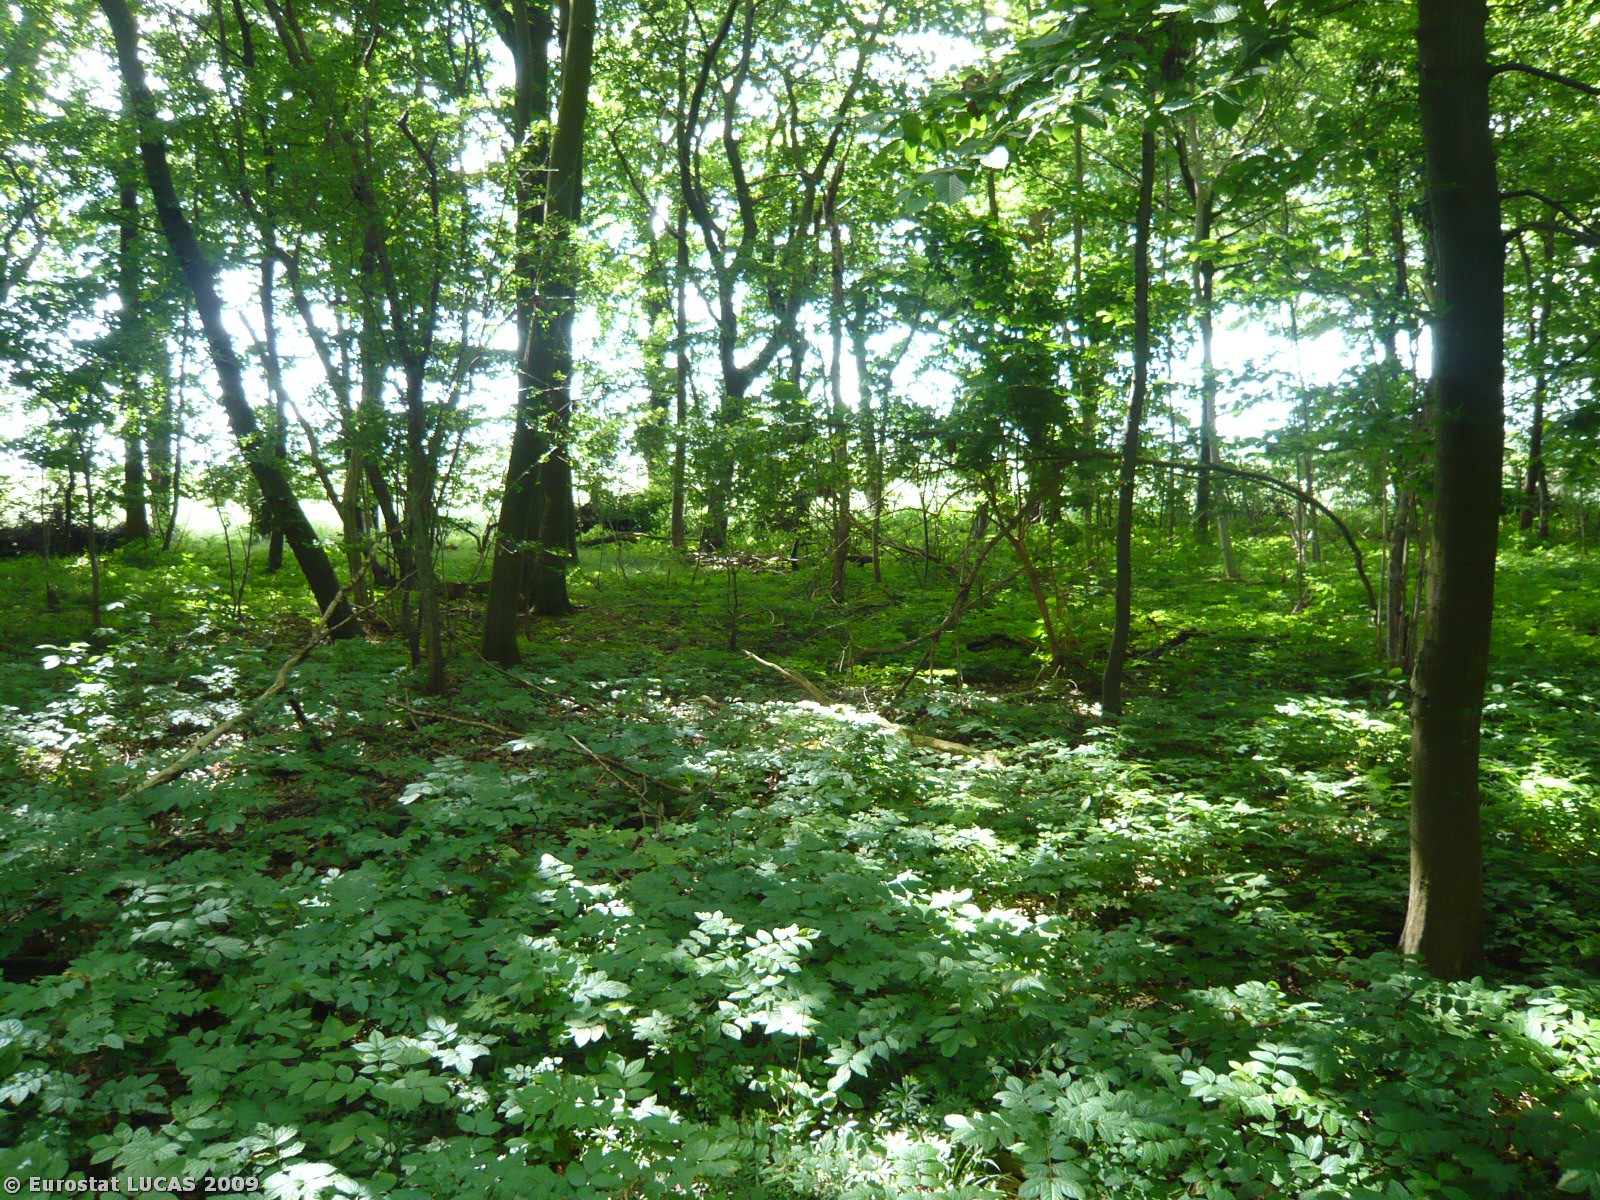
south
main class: Woodland
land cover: Broadleaved woodland
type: mesophytic deciduous forest
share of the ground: > 75 %
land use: Forestry
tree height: > 5 m
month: June
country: DK
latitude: 54.7200
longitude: 11.7222
